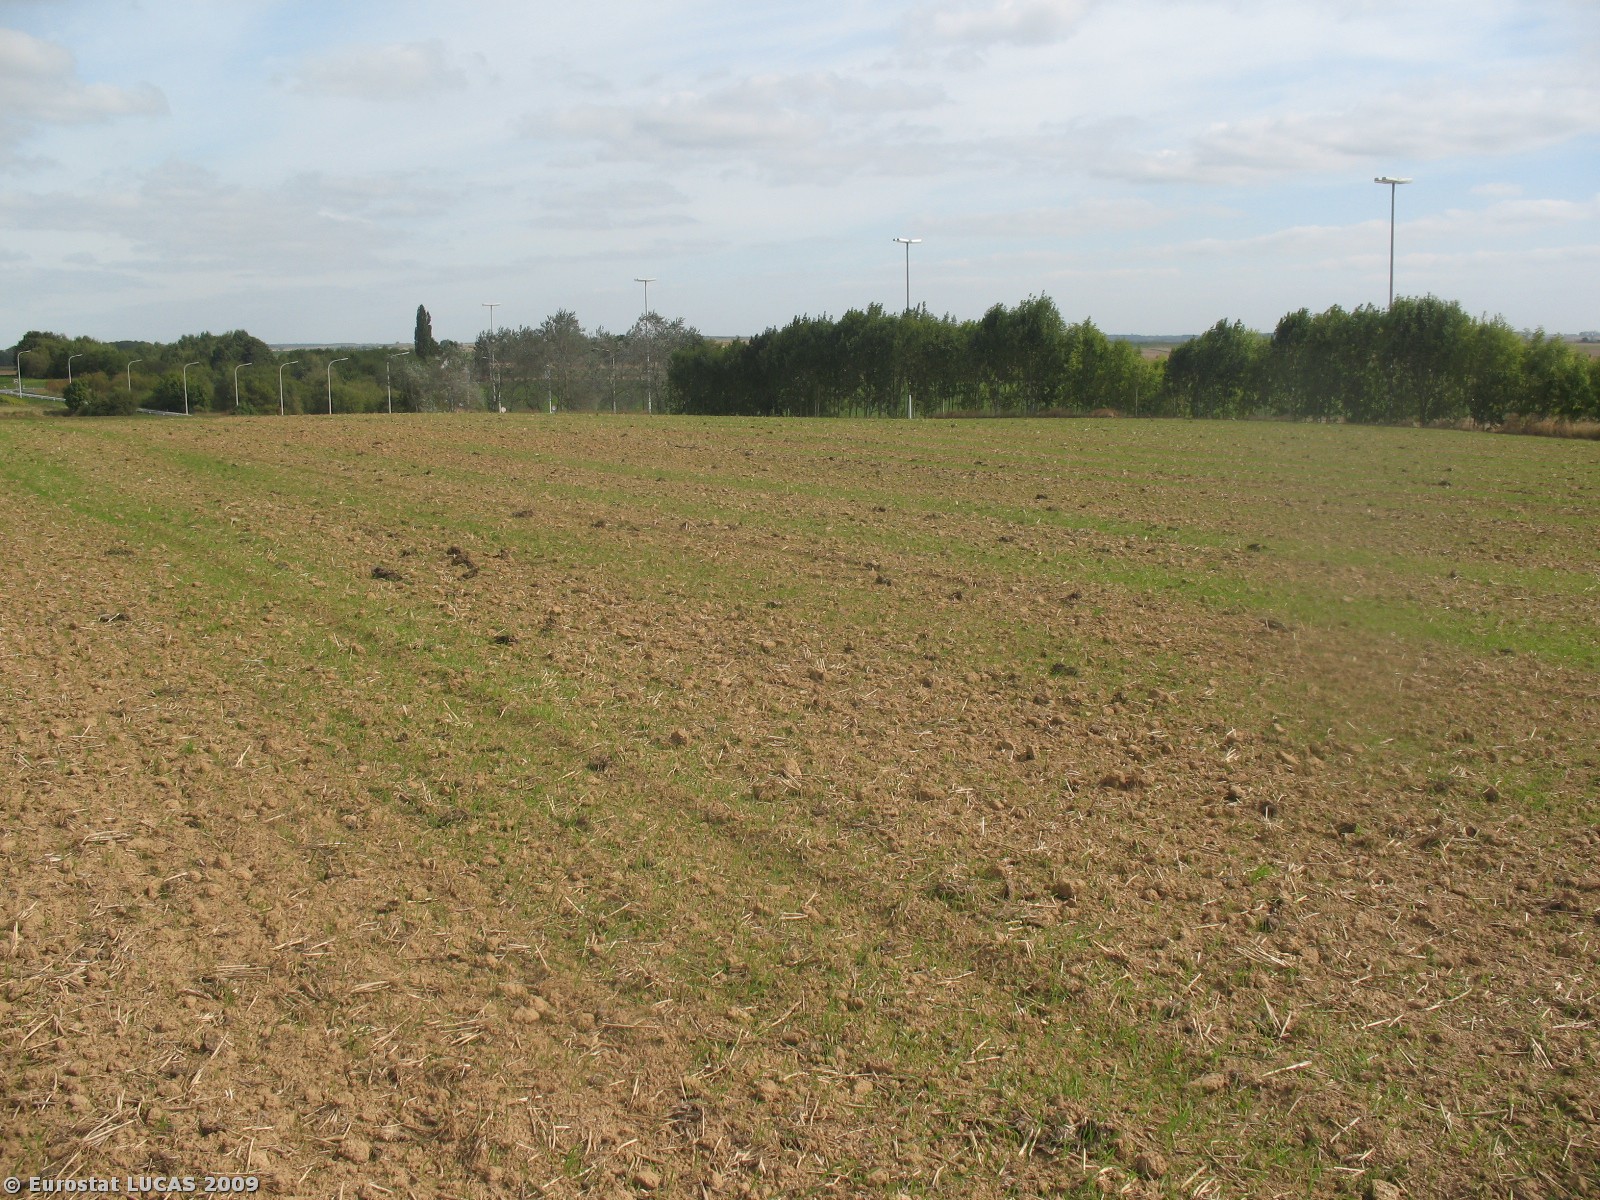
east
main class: Cropland
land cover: Temporary grasslands
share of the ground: < 10 %
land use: Agriculture (excluding fallow land and kitchen gardens)
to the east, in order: Temporary grasslands; Broadleaved woodland; Ditches and canals; Grass margins; Fences; Paved roads, cycling and walking lanes; Fences; Electric lines; Fences; Paved roads, cycling and walking lanes; Fences; Ditches and canals; Grass margins; Common wheat
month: September
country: BE
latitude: 50.3205
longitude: 4.1098
